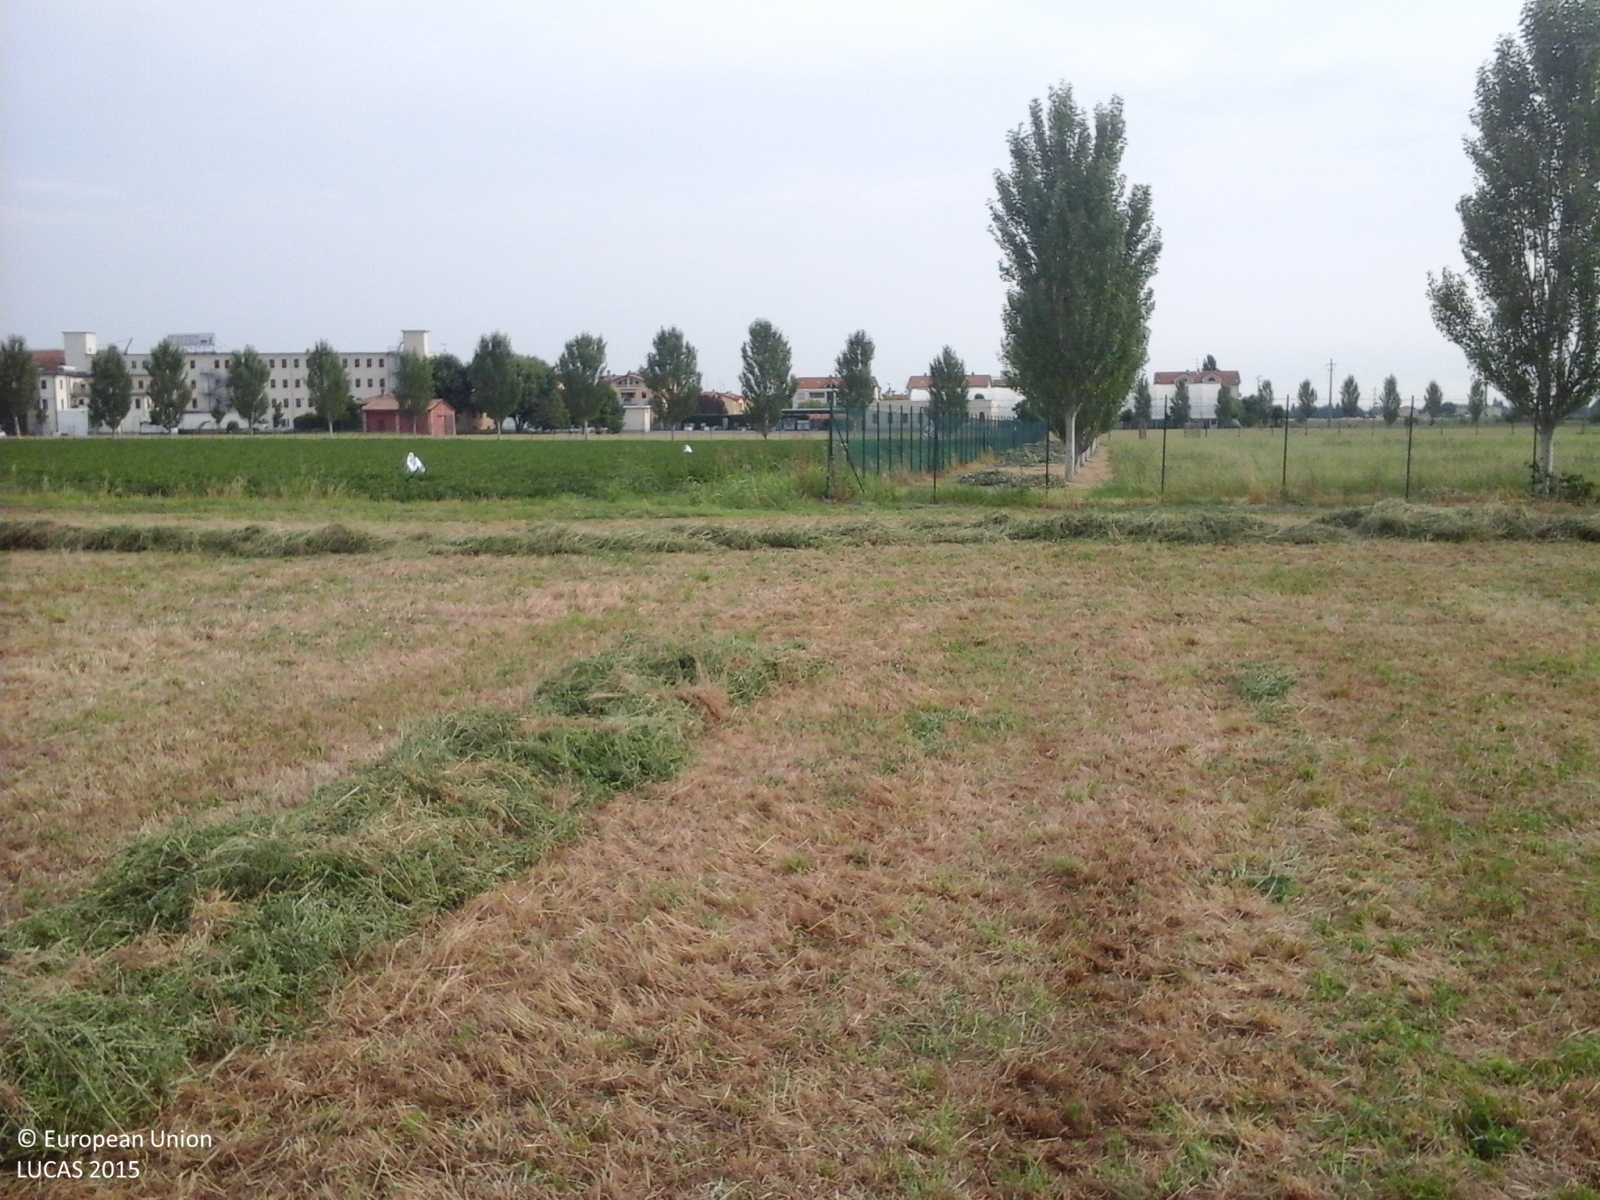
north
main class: Cropland
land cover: Lucerne
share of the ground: > 75 %
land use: Agriculture (excluding fallow land and kitchen gardens)
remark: Clear cut
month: June
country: IT
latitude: 44.6748
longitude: 10.2895
